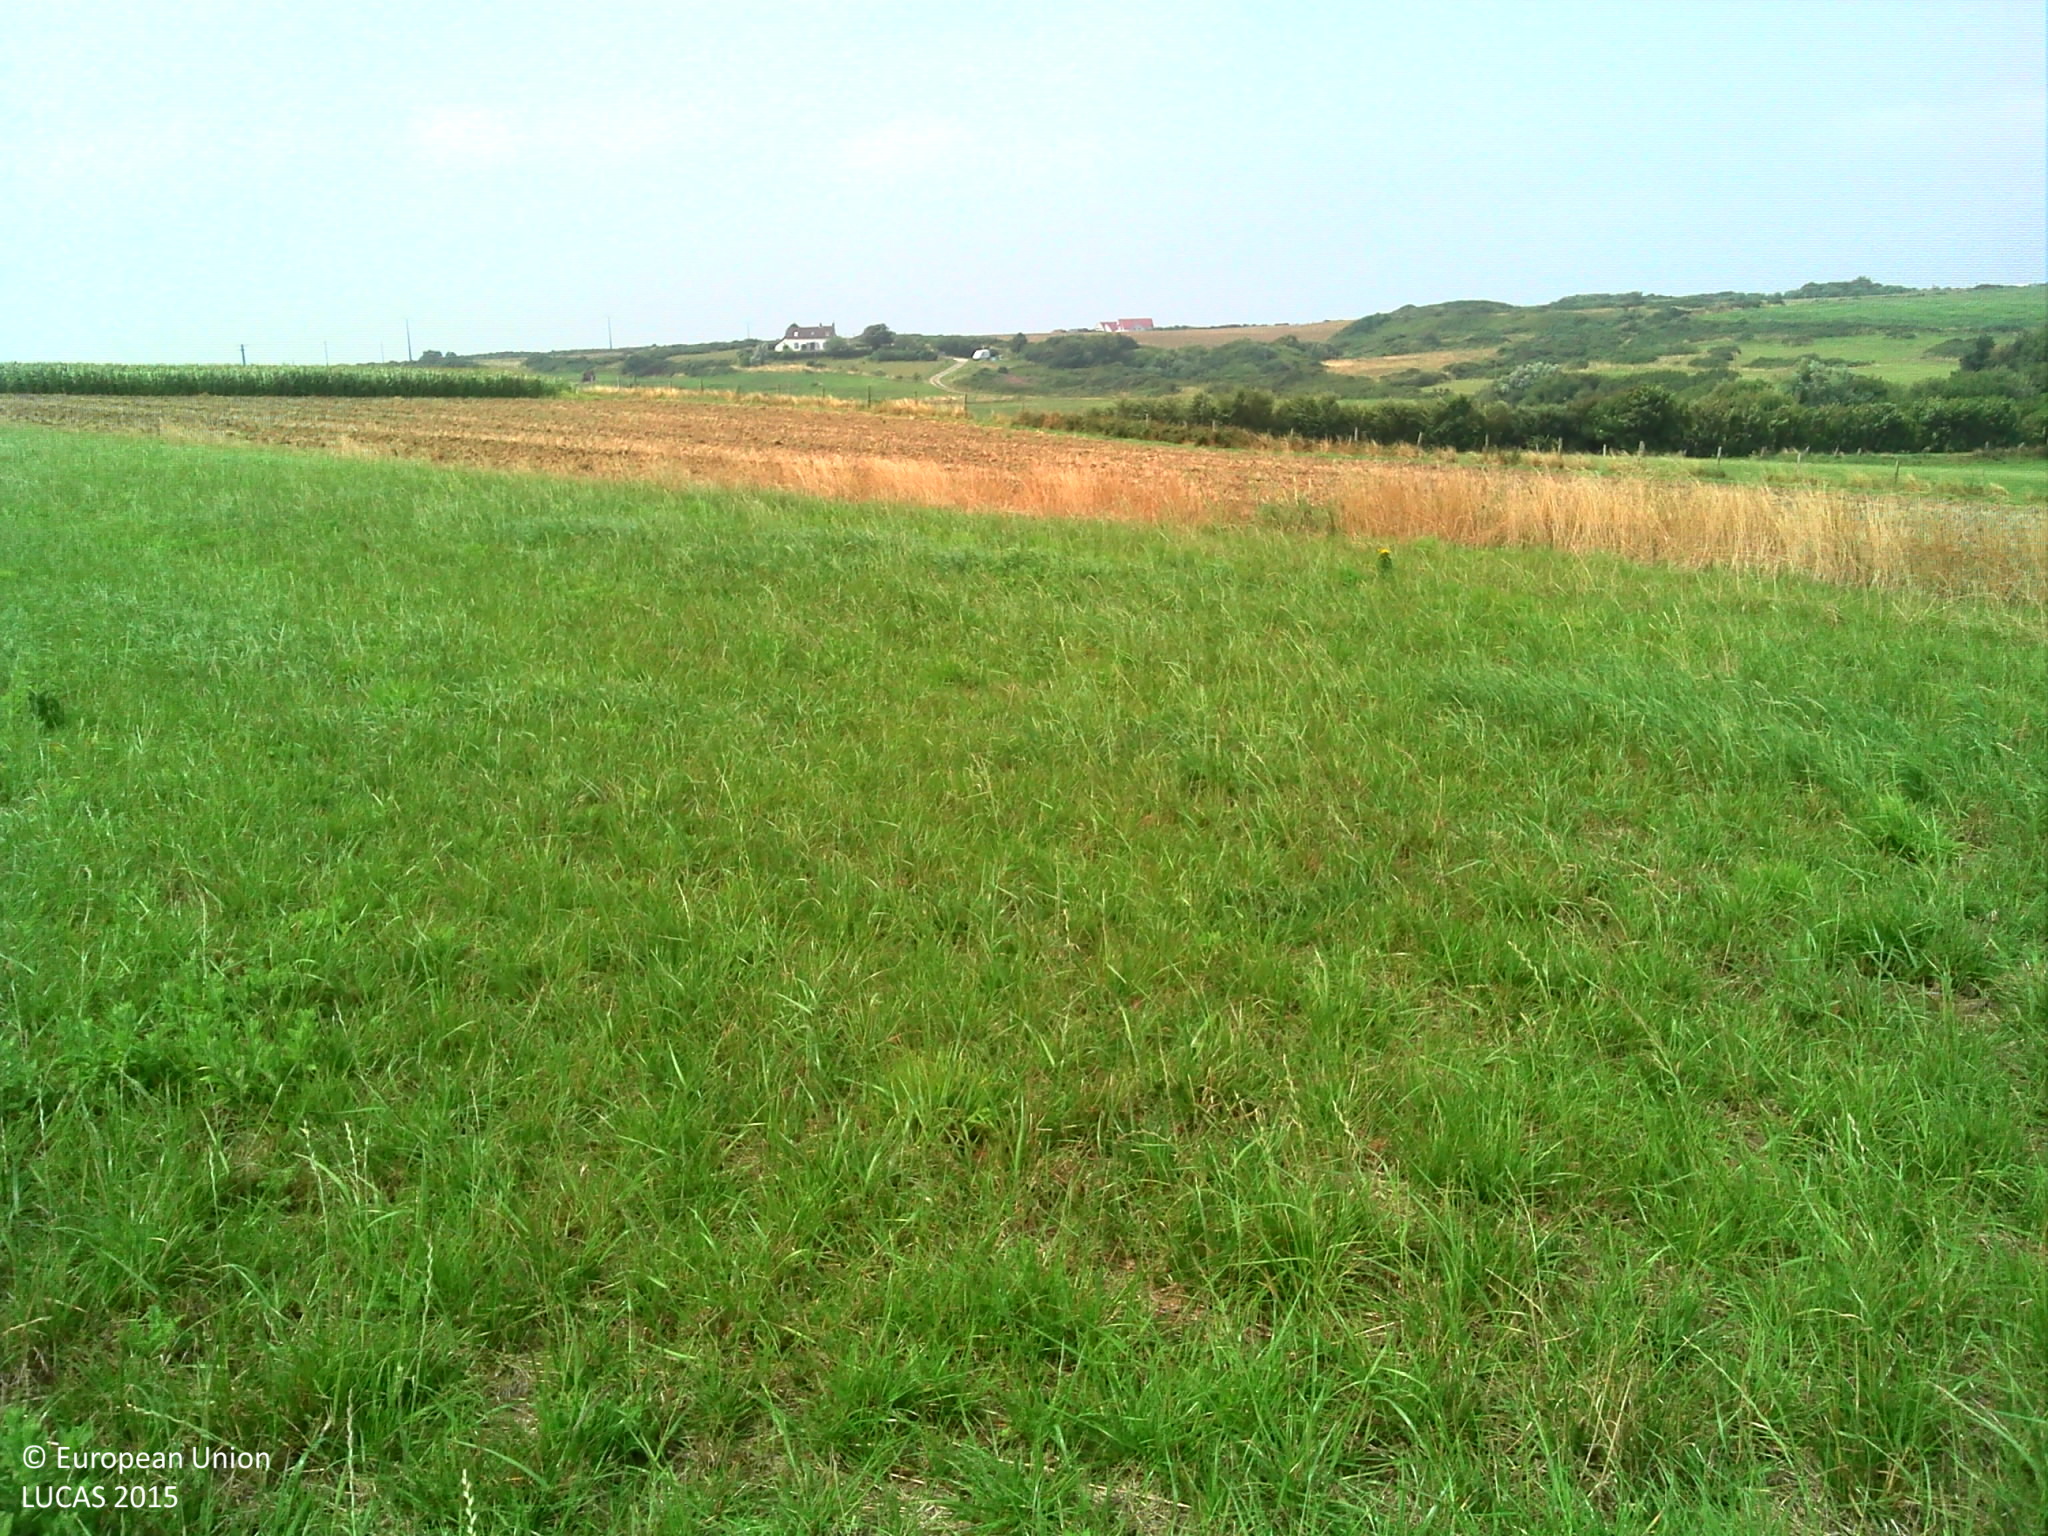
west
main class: Cropland
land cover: Temporary grasslands
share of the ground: > 75 %
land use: Agriculture (excluding fallow land and kitchen gardens)
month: August
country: FR
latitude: 50.6687
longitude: 1.5911
